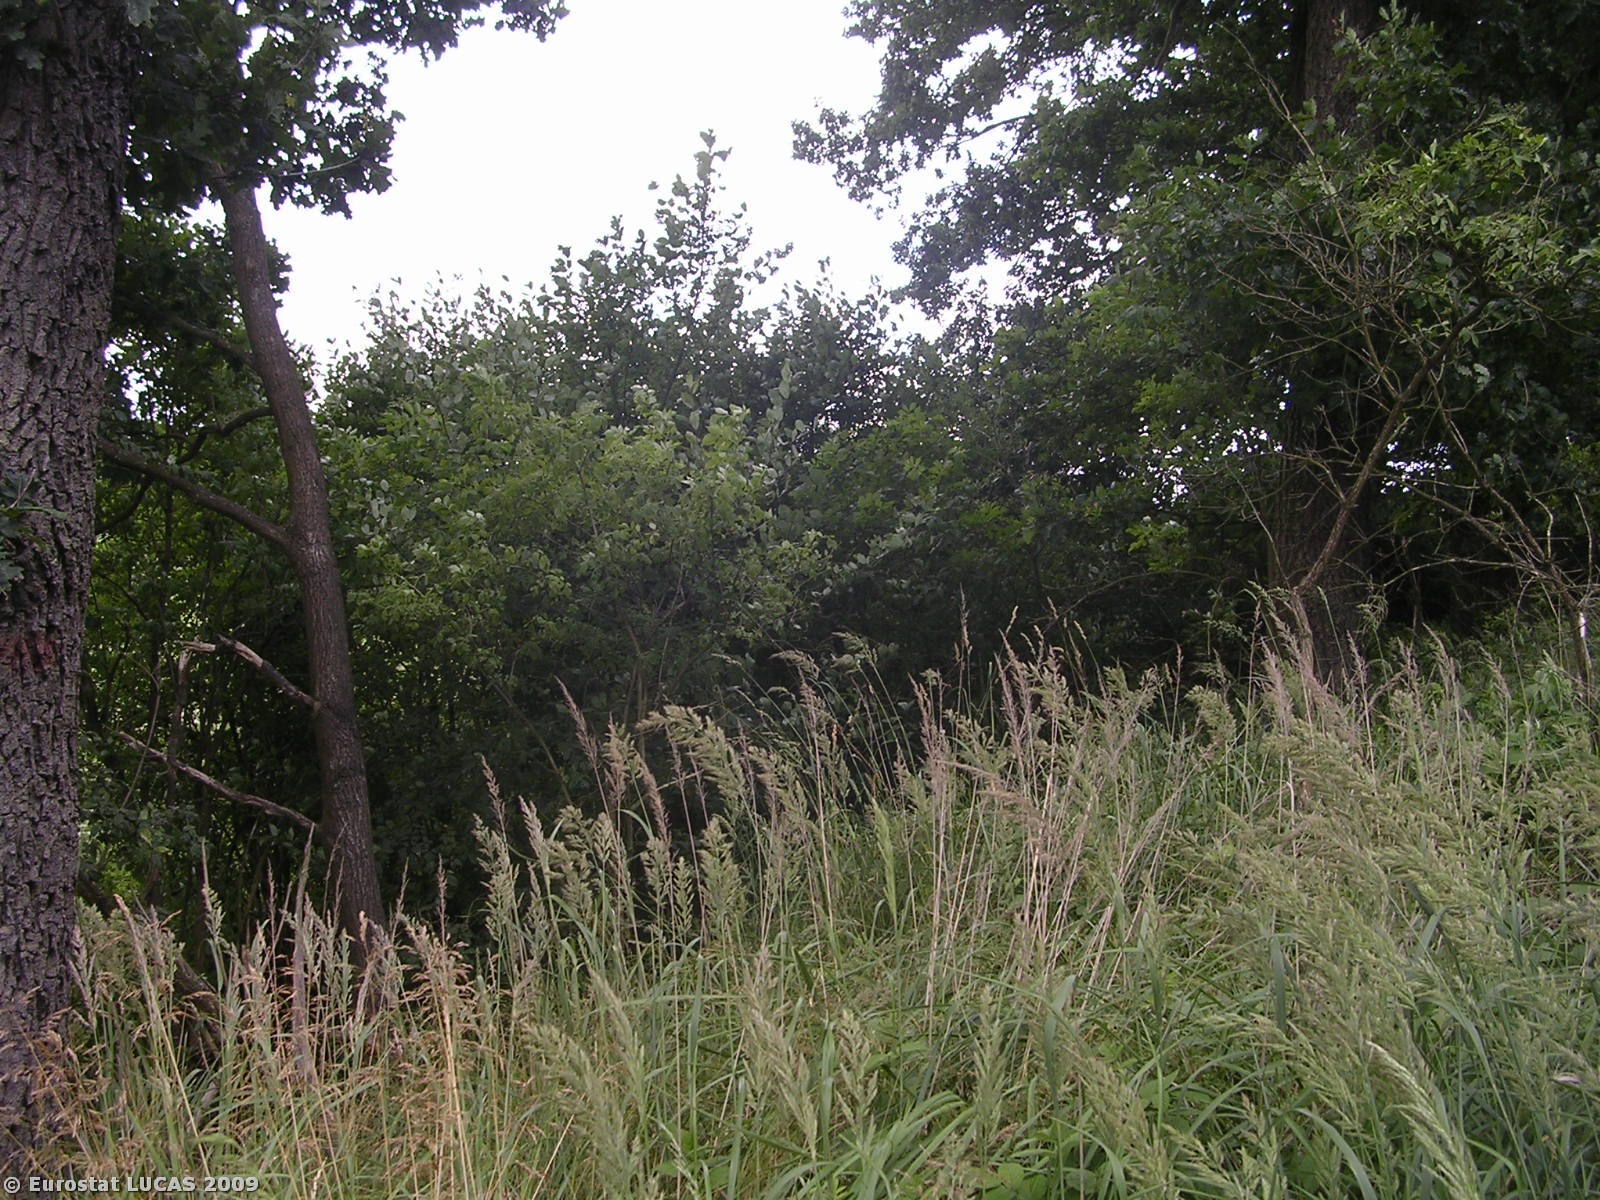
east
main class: Woodland
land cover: Broadleaved woodland
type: acidophilous oak and oak-birch forest
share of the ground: 50 - 75 %
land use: Forestry
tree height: > 5 m
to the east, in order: Broadleaved woodland; Shrubland without tree cover; Grassland without tree/shrub cover; Shruby margins; Paved roads, cycling and walking lanes
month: July
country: CZ
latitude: 50.6655
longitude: 14.6568
